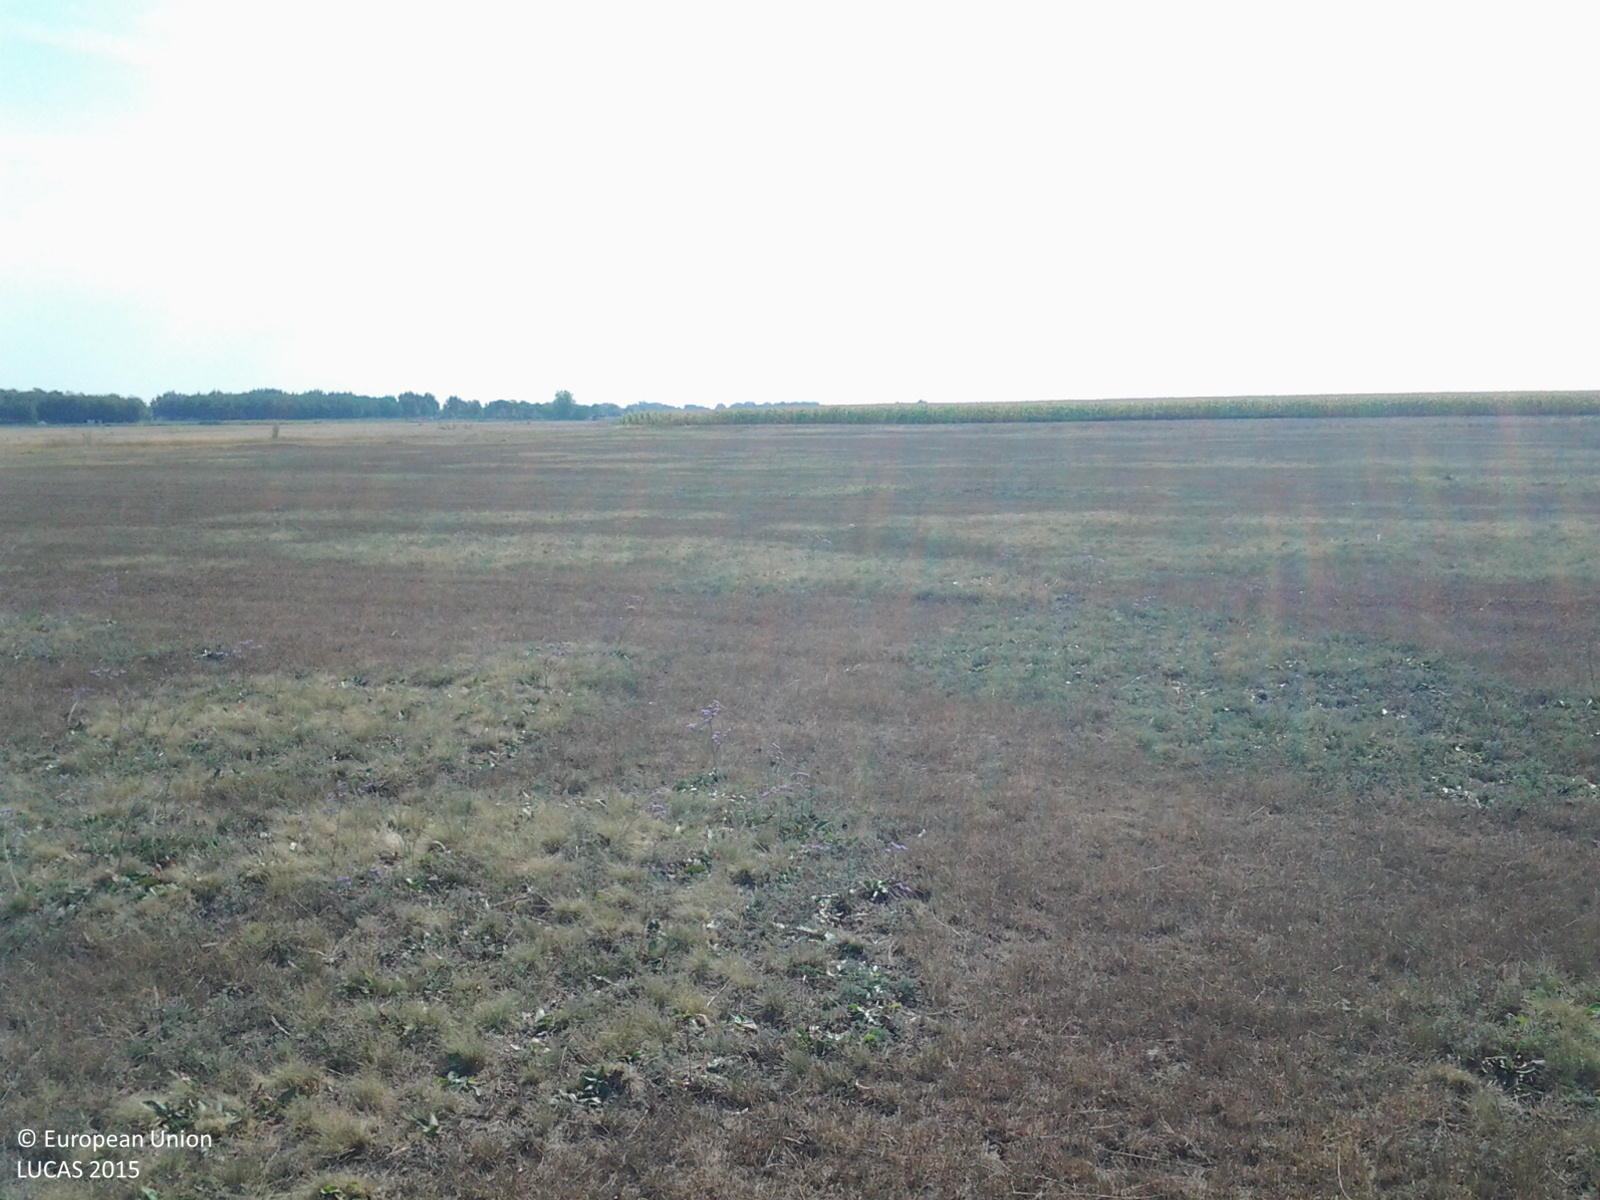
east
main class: Grassland
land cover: Grassland without tree/shrub cover
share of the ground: > 75 %
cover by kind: herbaceous plants 100 %
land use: Agriculture (excluding fallow land and kitchen gardens)
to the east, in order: Grassland without tree/shrub cover; Common wheat; Maize
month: August
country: HU
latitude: 47.4465
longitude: 19.7443
